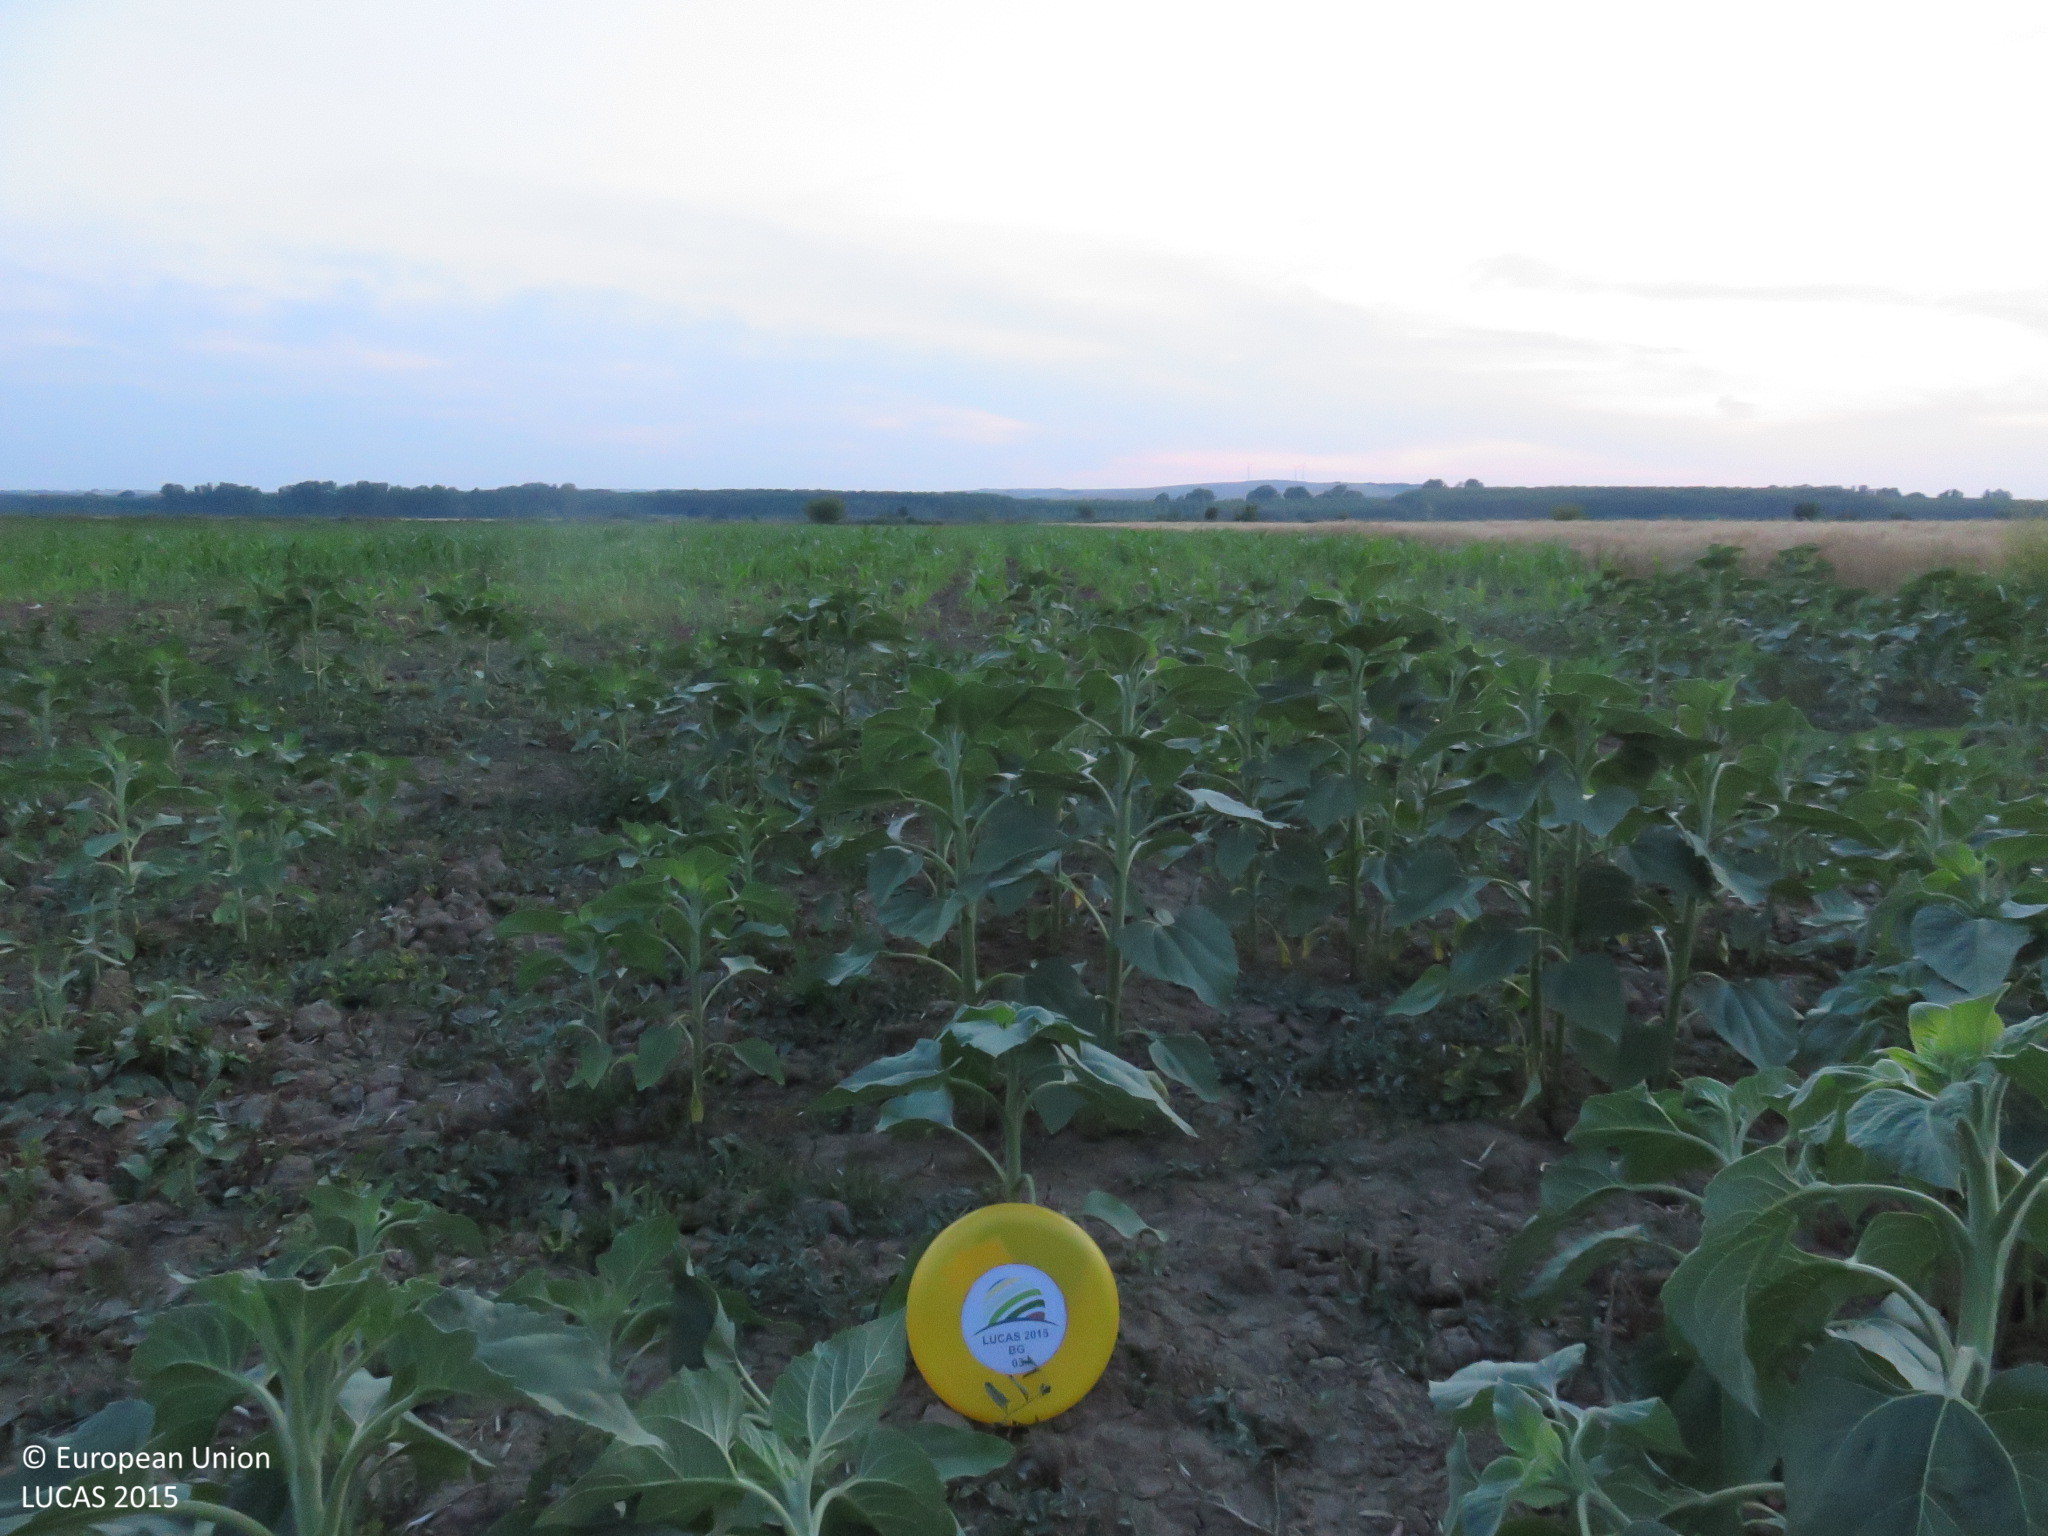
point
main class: Cropland
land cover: Sunflower
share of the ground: > 75 %
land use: Agriculture (excluding fallow land and kitchen gardens)
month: June
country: BG
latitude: 43.6963
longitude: 24.4684
